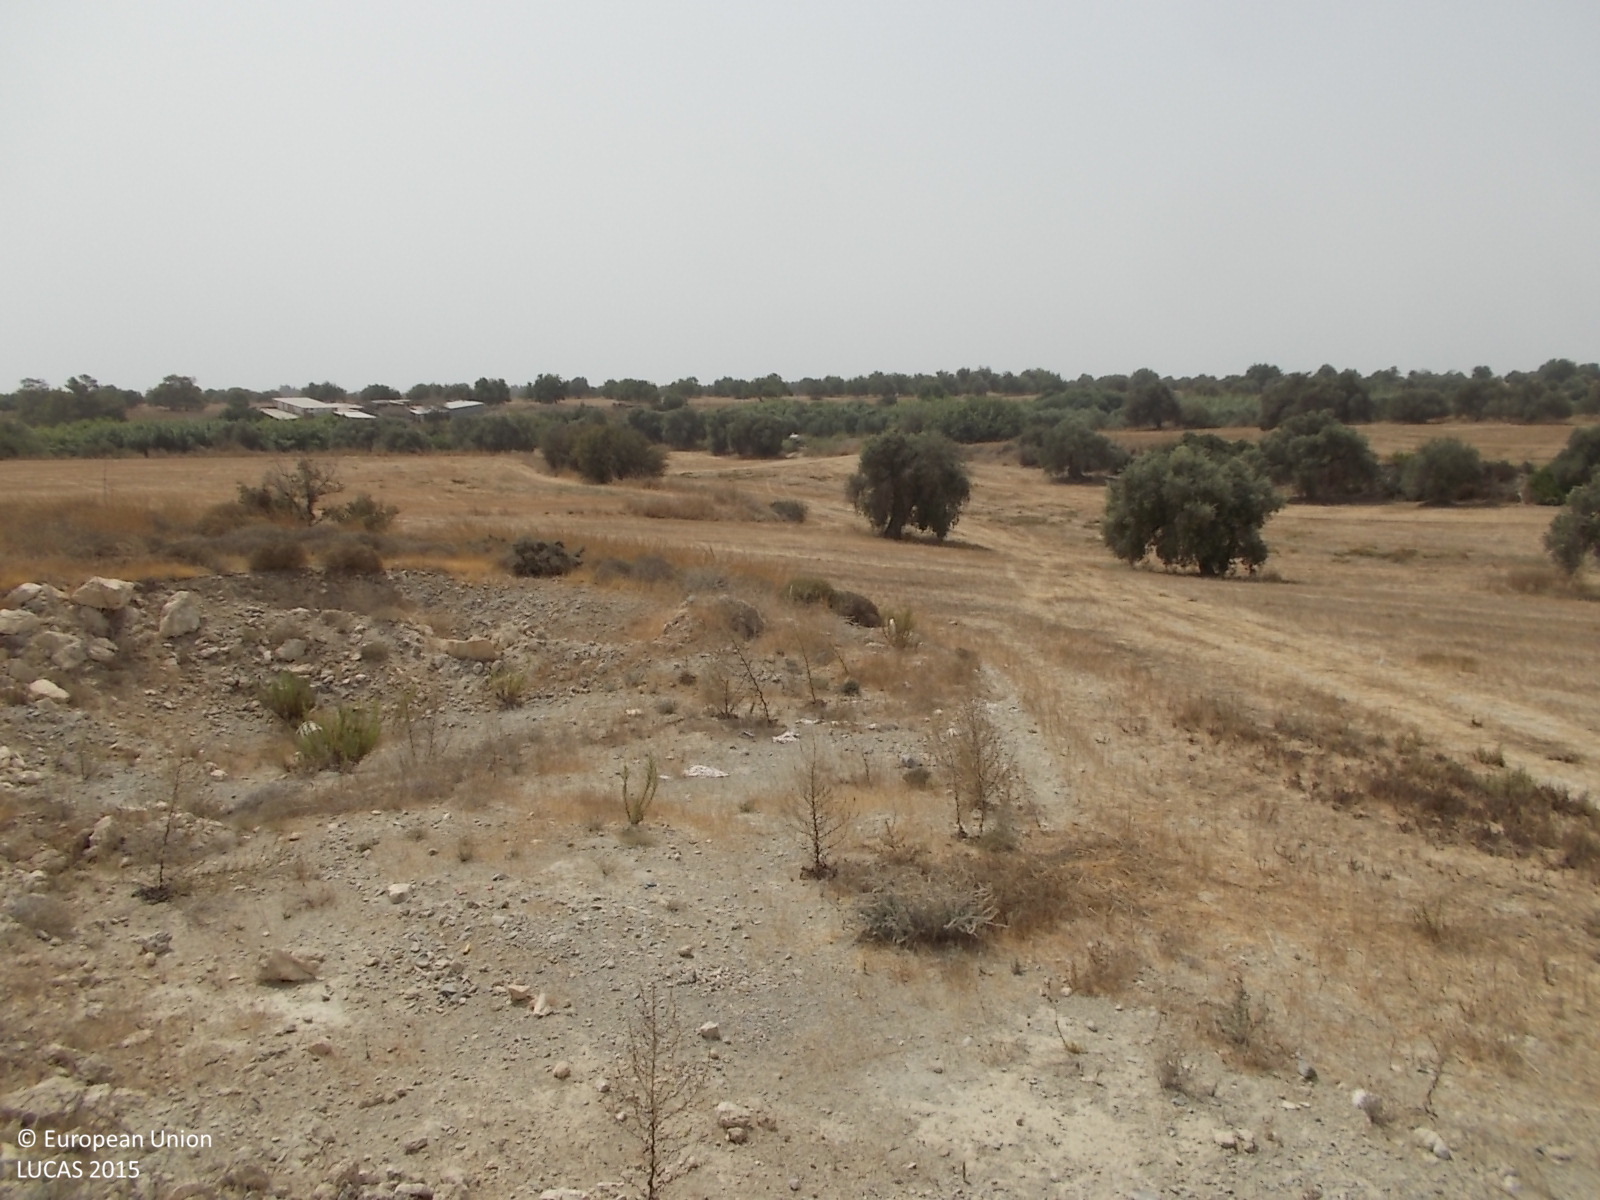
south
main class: Shrubland
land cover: Shrubland with sparse tree cover
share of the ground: 50 - 75 %
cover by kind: shrubs 55 %, herbaceous plants 20 %, unconsolidated bare surface 15 %, broadleaved forest trees 5 %, consolidated bare surface 5 %
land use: Semi-natural and natural areas not in use
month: April
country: CY
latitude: 34.8133
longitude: 33.5057
